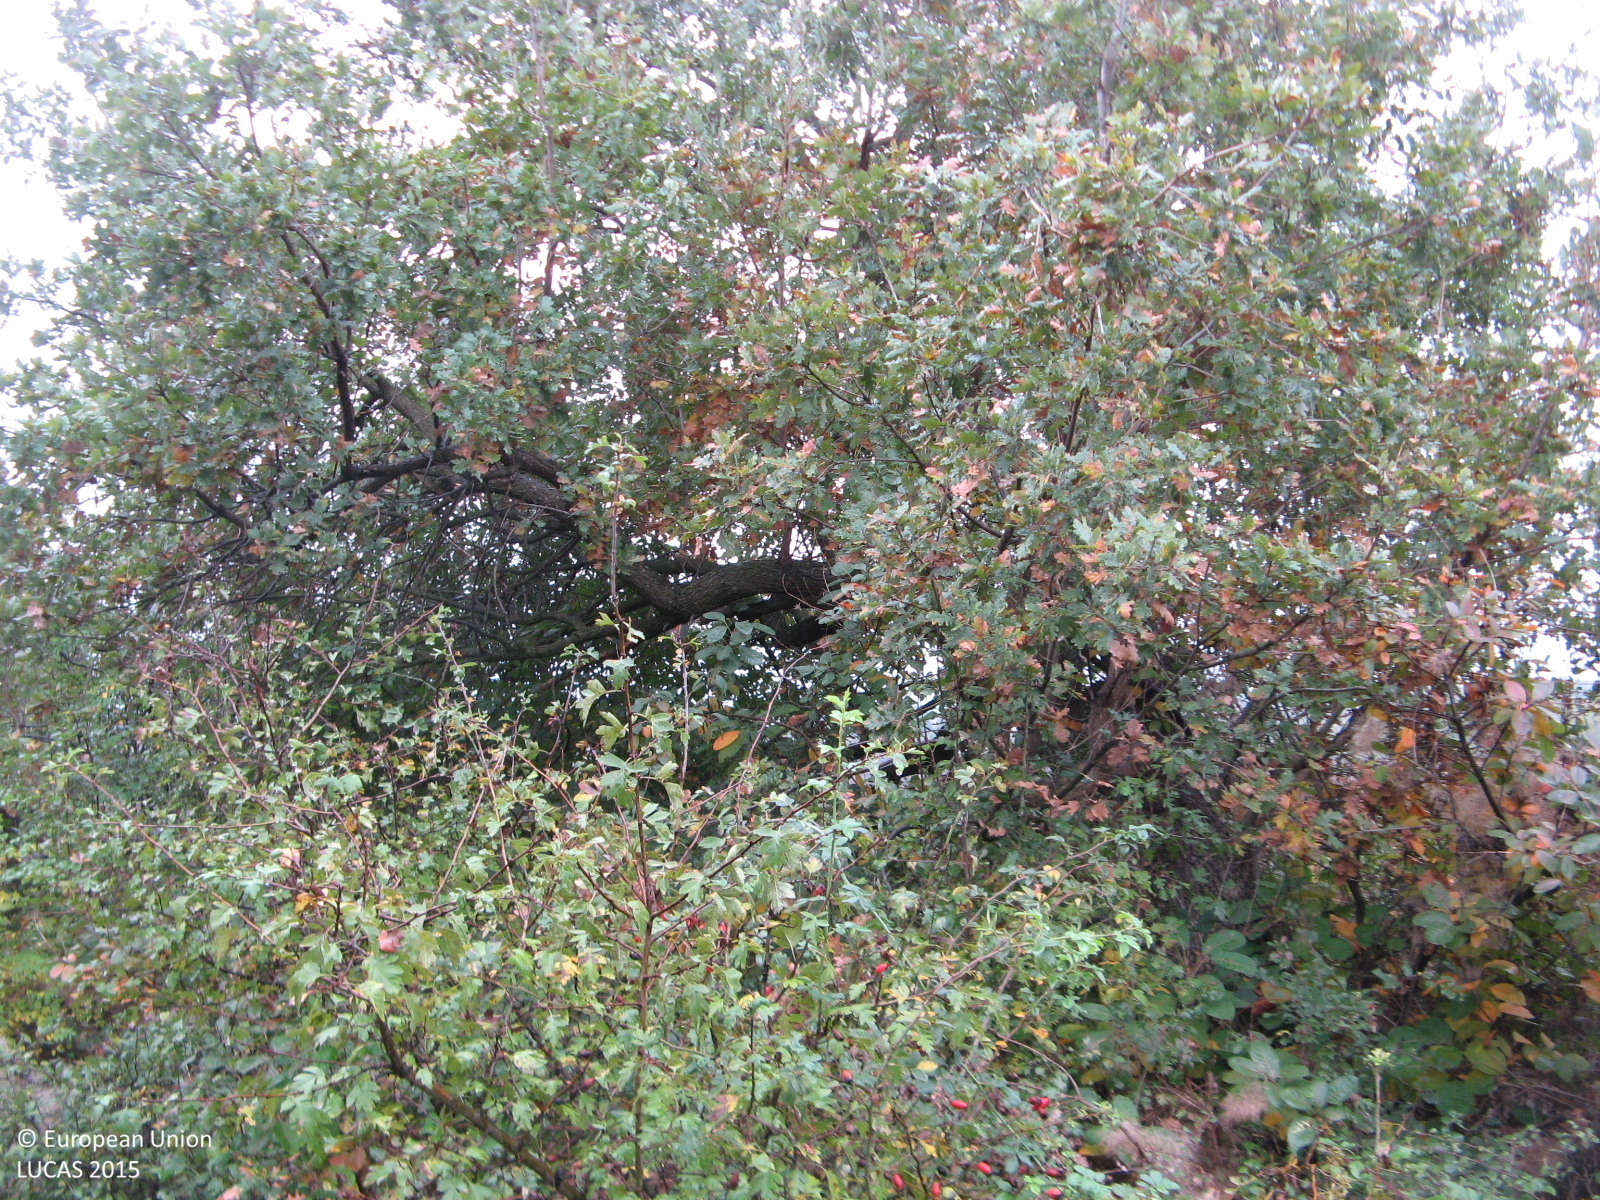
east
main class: Woodland
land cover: Broadleaved woodland
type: mesophytic deciduous forest
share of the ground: > 75 %
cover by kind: broadleaved forest trees 95 %, unconsolidated bare surface 5 %
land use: Forestry
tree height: > 5 m
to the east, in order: Broadleaved woodland
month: October
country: BG
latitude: 42.0361
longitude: 25.0464
